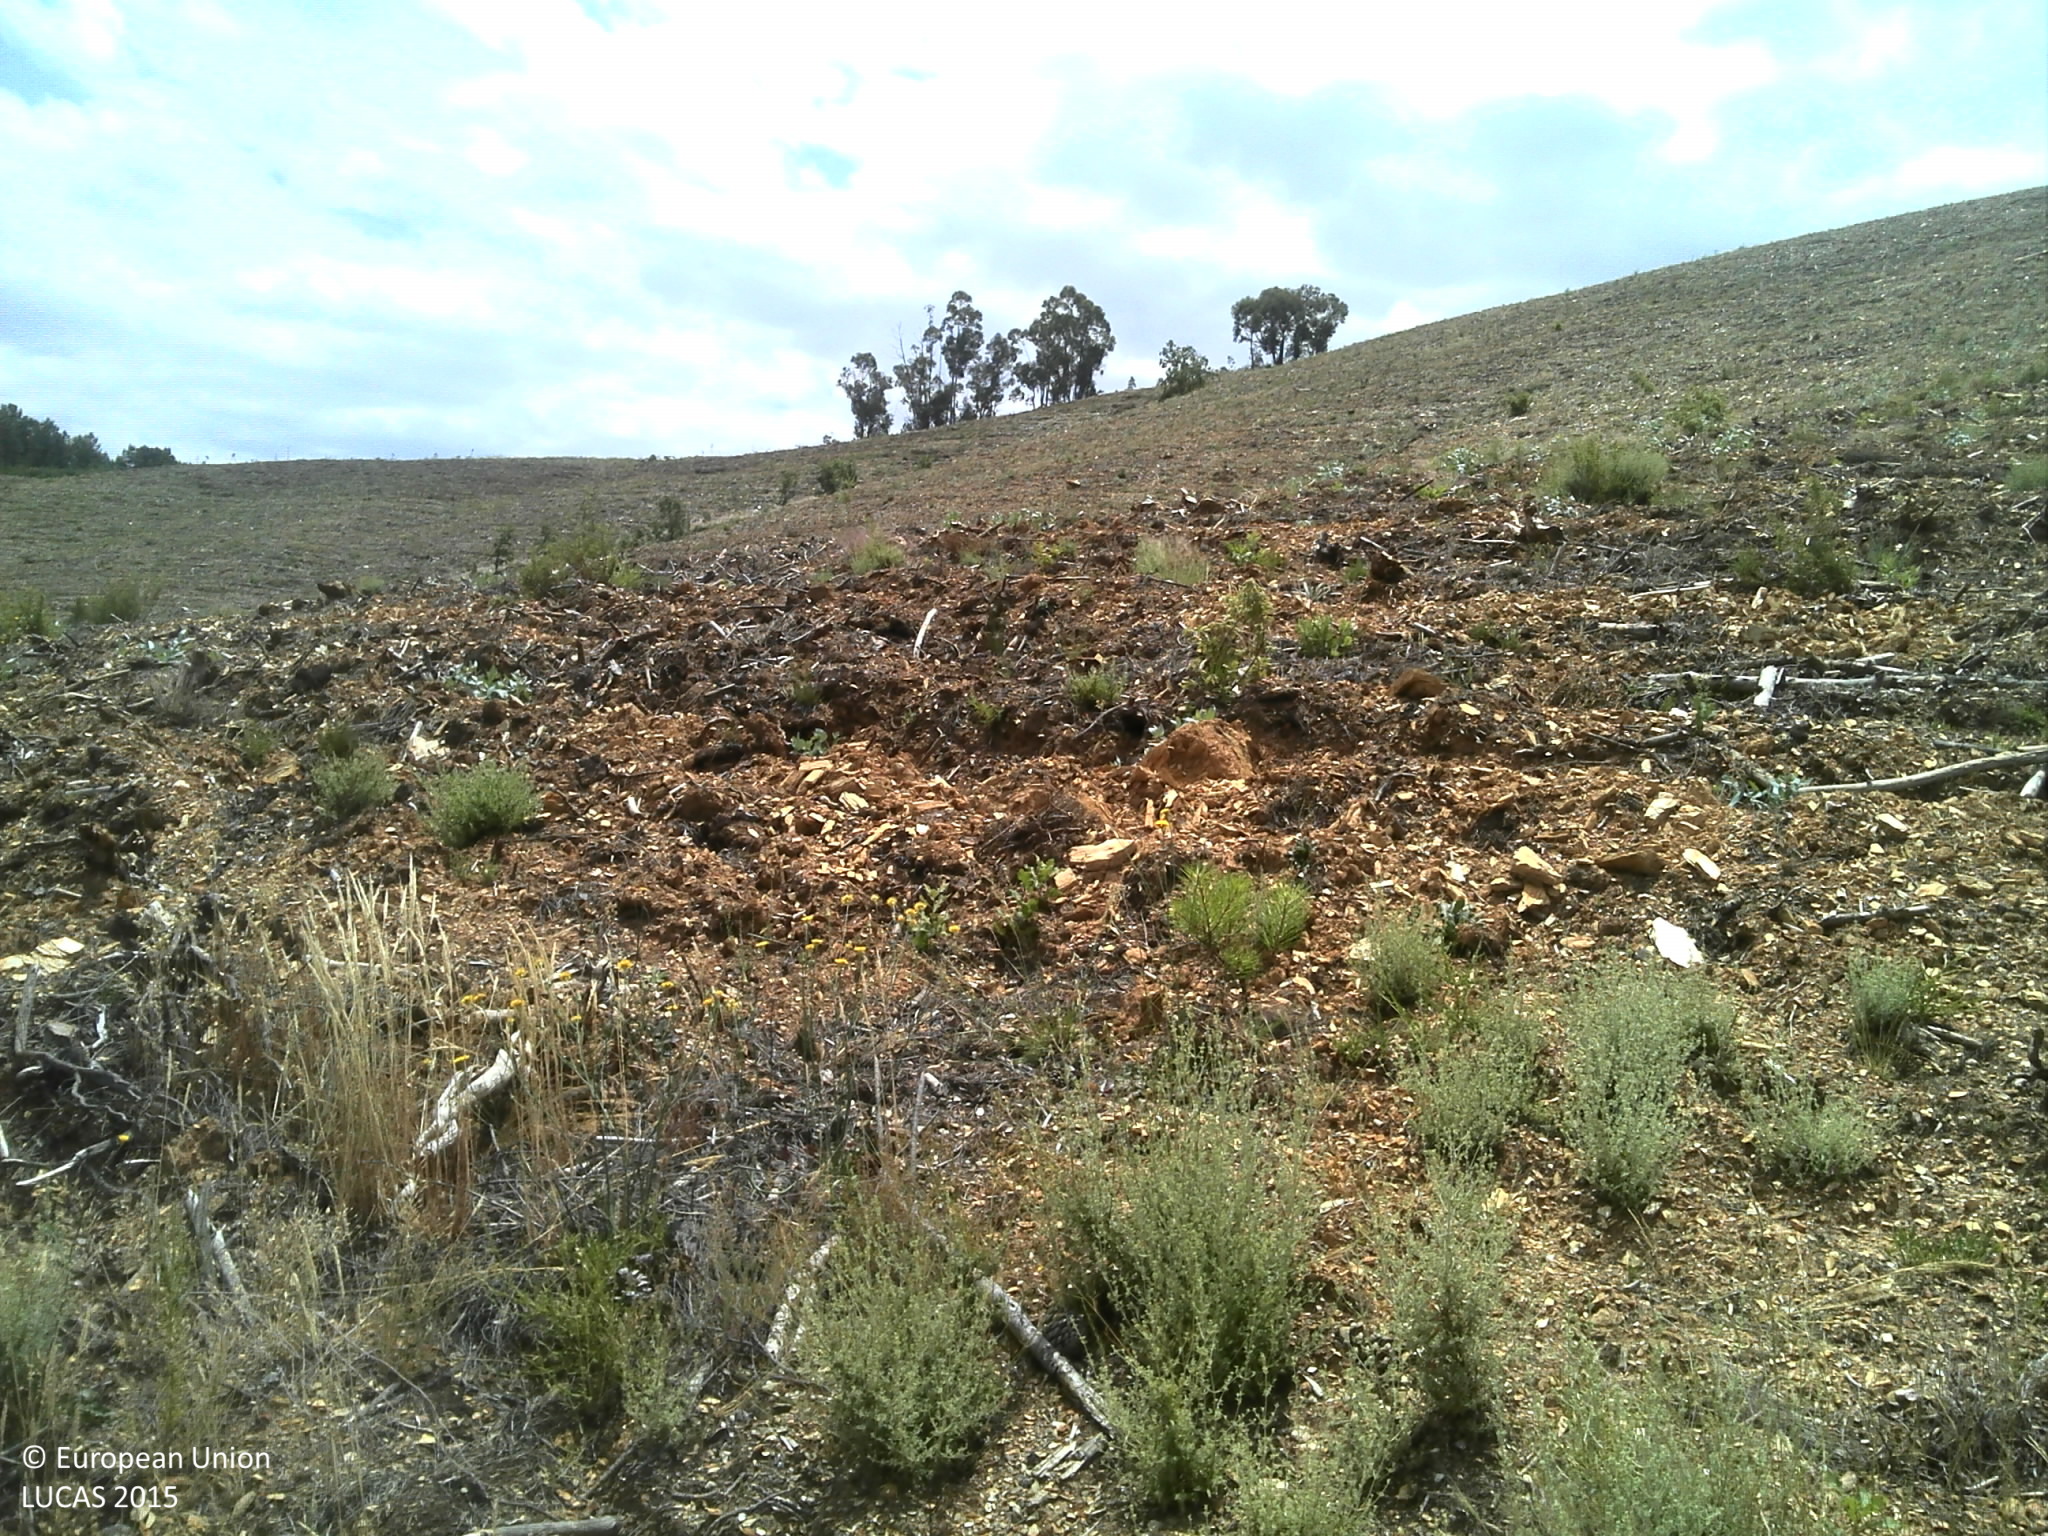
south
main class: Woodland
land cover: Broadleaved woodland
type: exotic forest
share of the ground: < 10 %
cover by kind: unconsolidated bare surface 85 %, broadleaved forest trees 10 %, herbaceous plants 5 %
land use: Forestry
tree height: < 5 m
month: June
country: PT
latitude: 40.1617
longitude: -7.3731
